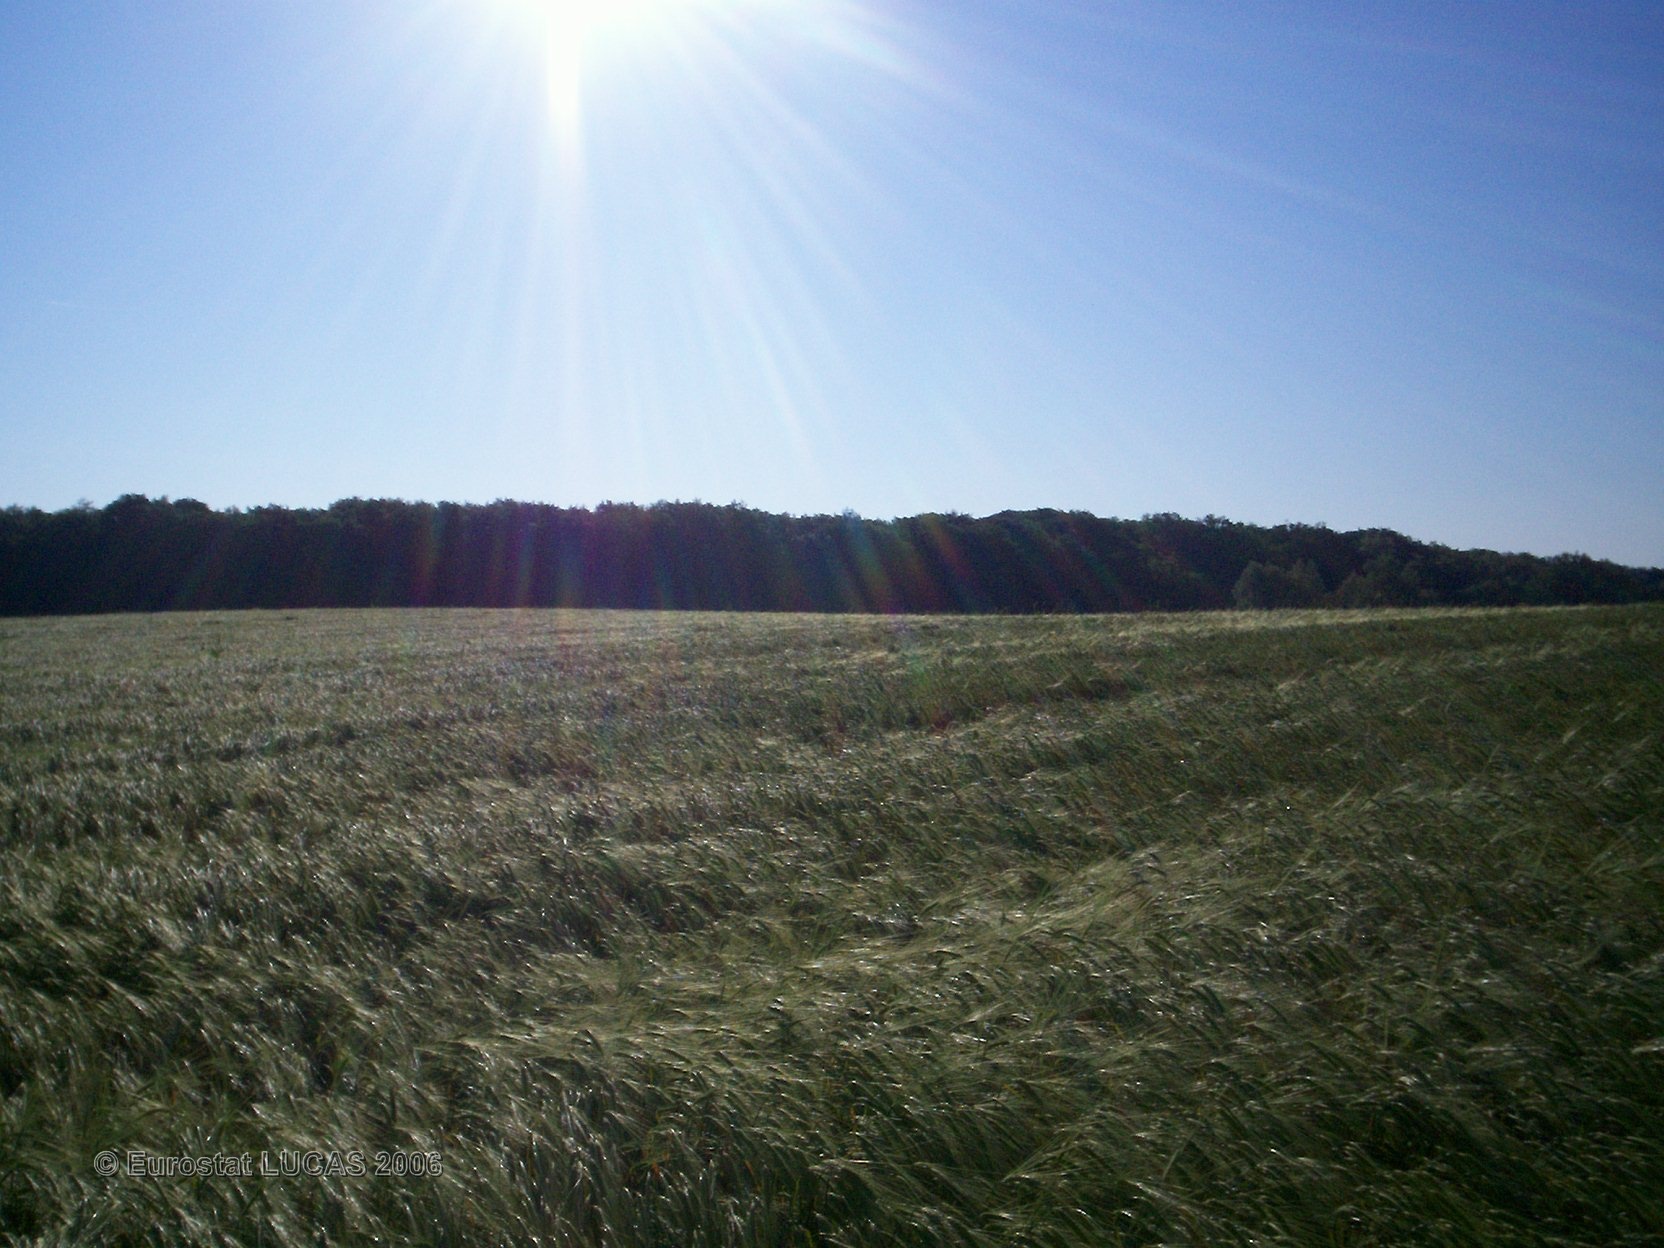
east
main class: Cropland
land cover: Barley
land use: Agriculture (excluding fallow land and kitchen gardens)
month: June
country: FR
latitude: 46.2441
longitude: 6.0995
